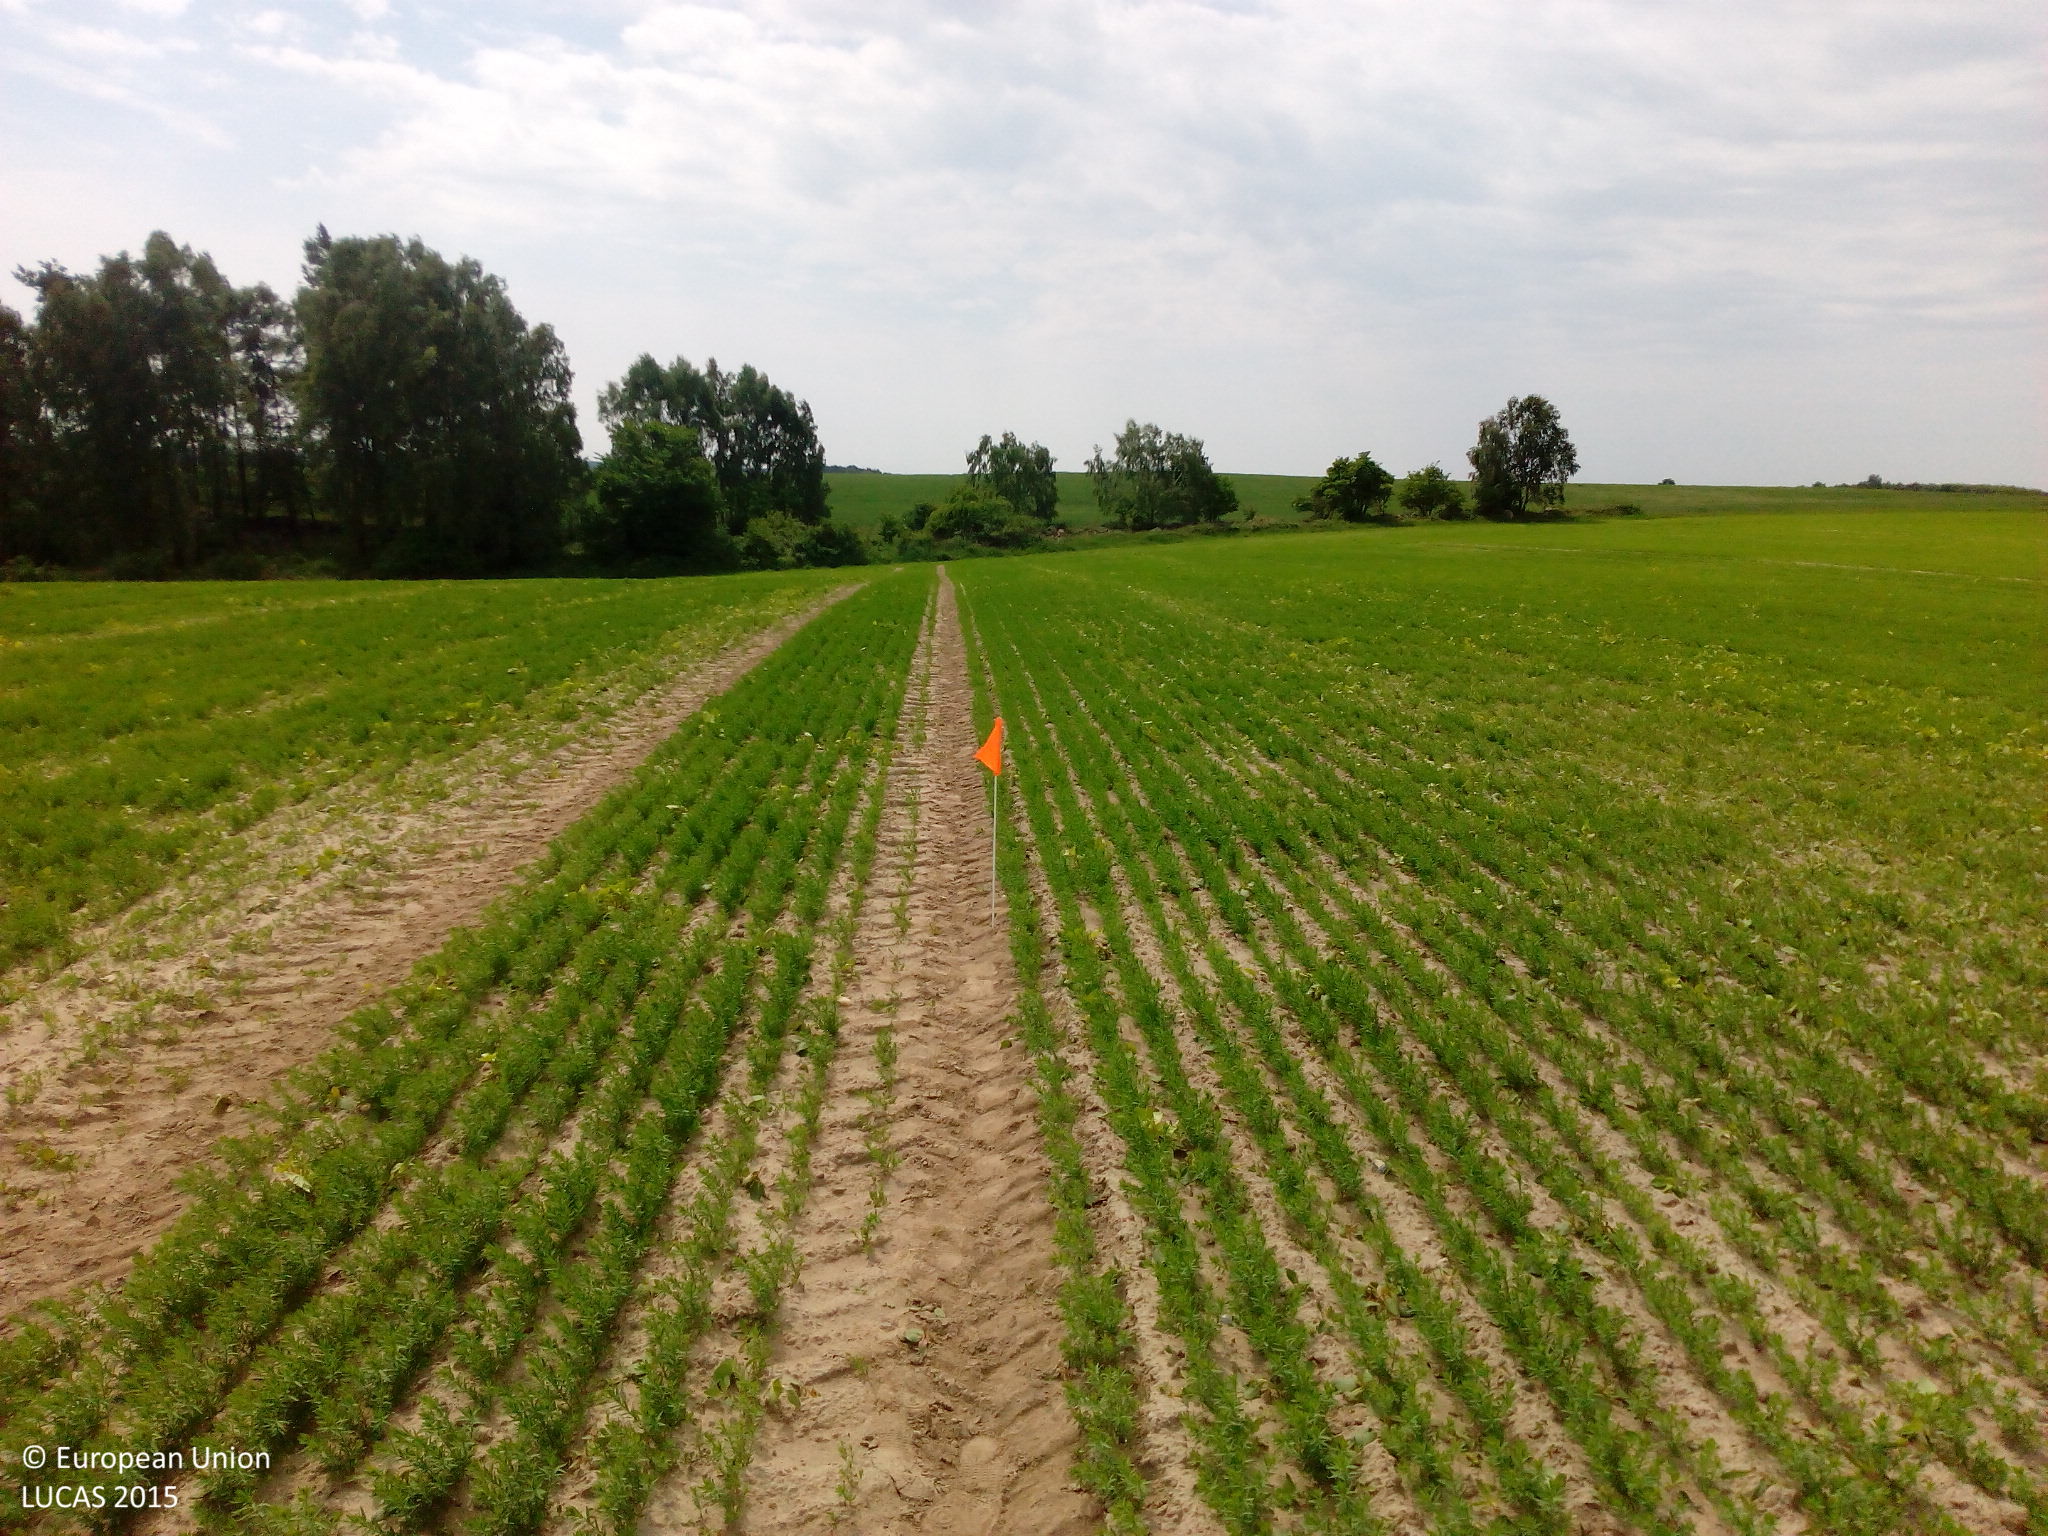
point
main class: Cropland
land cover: Lucerne
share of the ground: 10 - 25 %
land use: Agriculture (excluding fallow land and kitchen gardens)
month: May
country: DE
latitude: 52.0797
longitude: 12.5824
